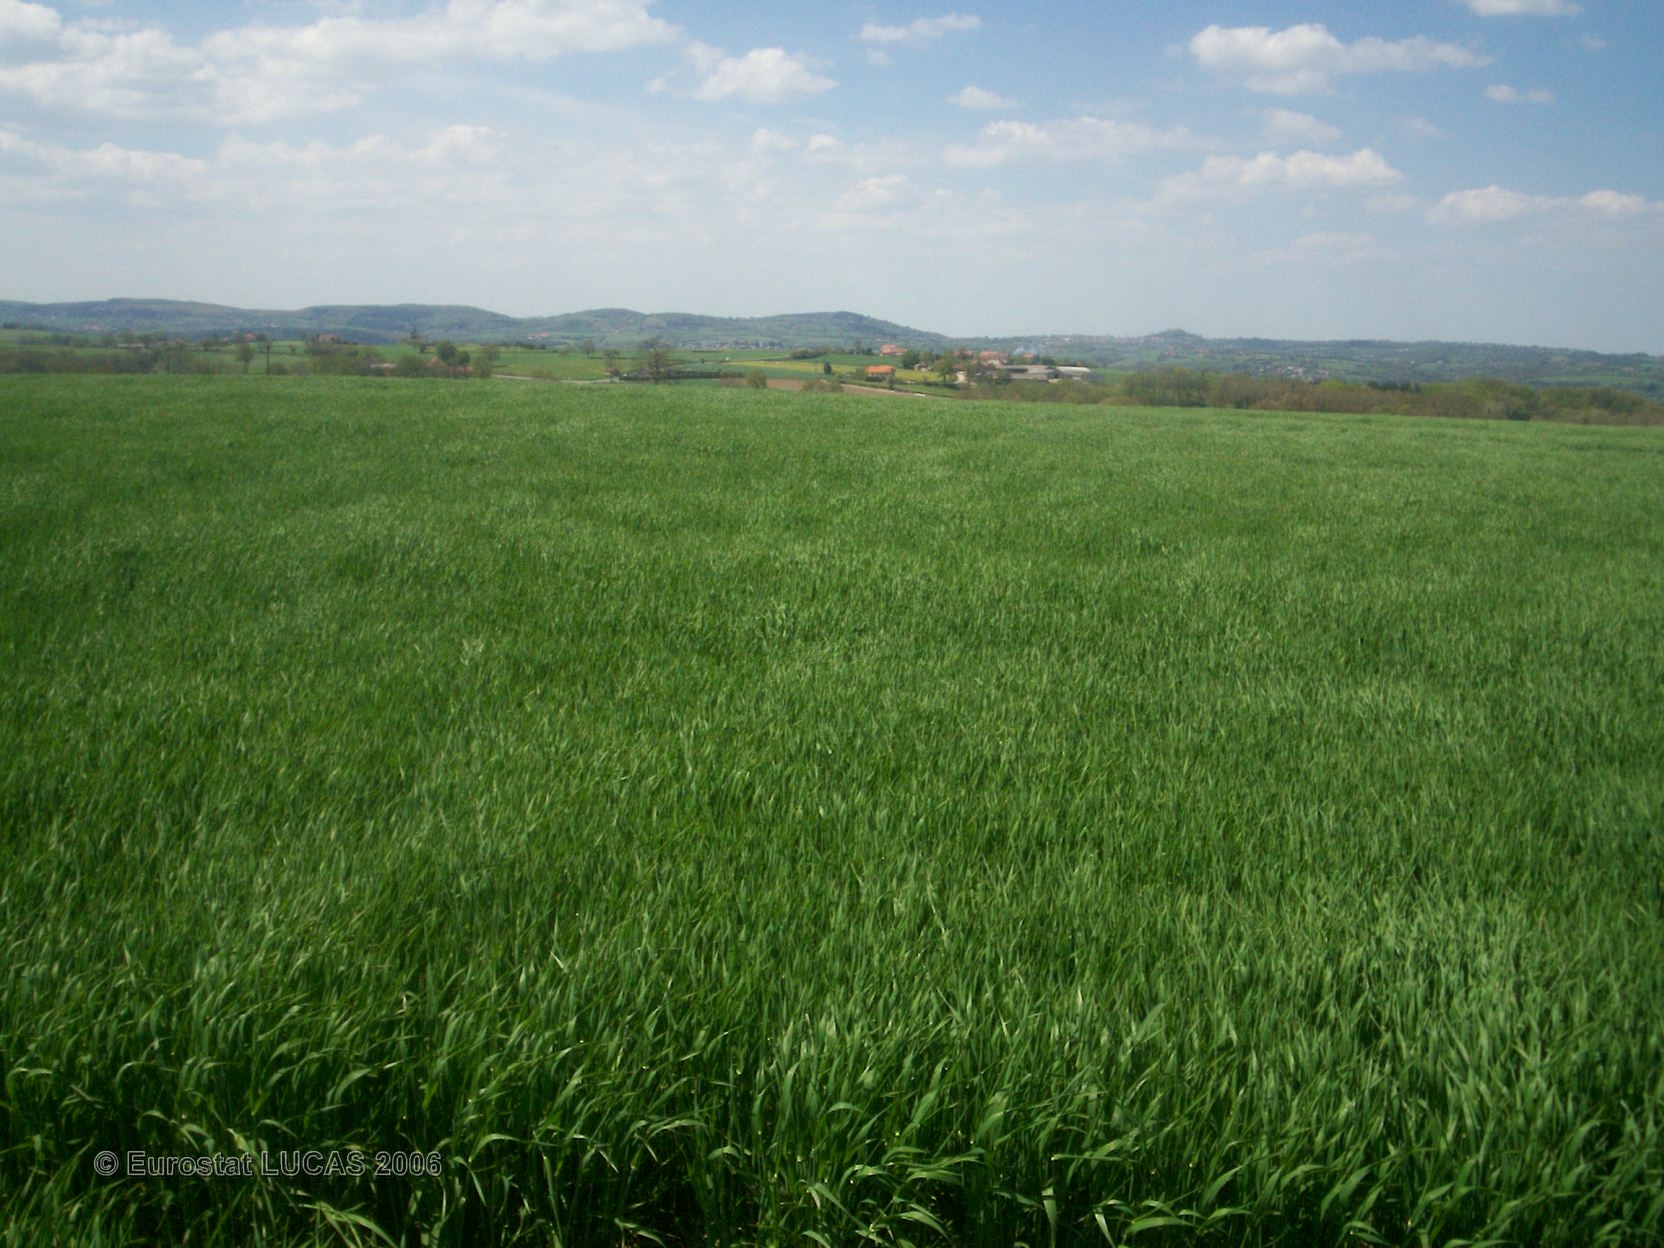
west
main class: Cropland
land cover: Barley
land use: Agriculture (excluding fallow land and kitchen gardens)
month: May
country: FR
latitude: 46.1506
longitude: 2.8896
